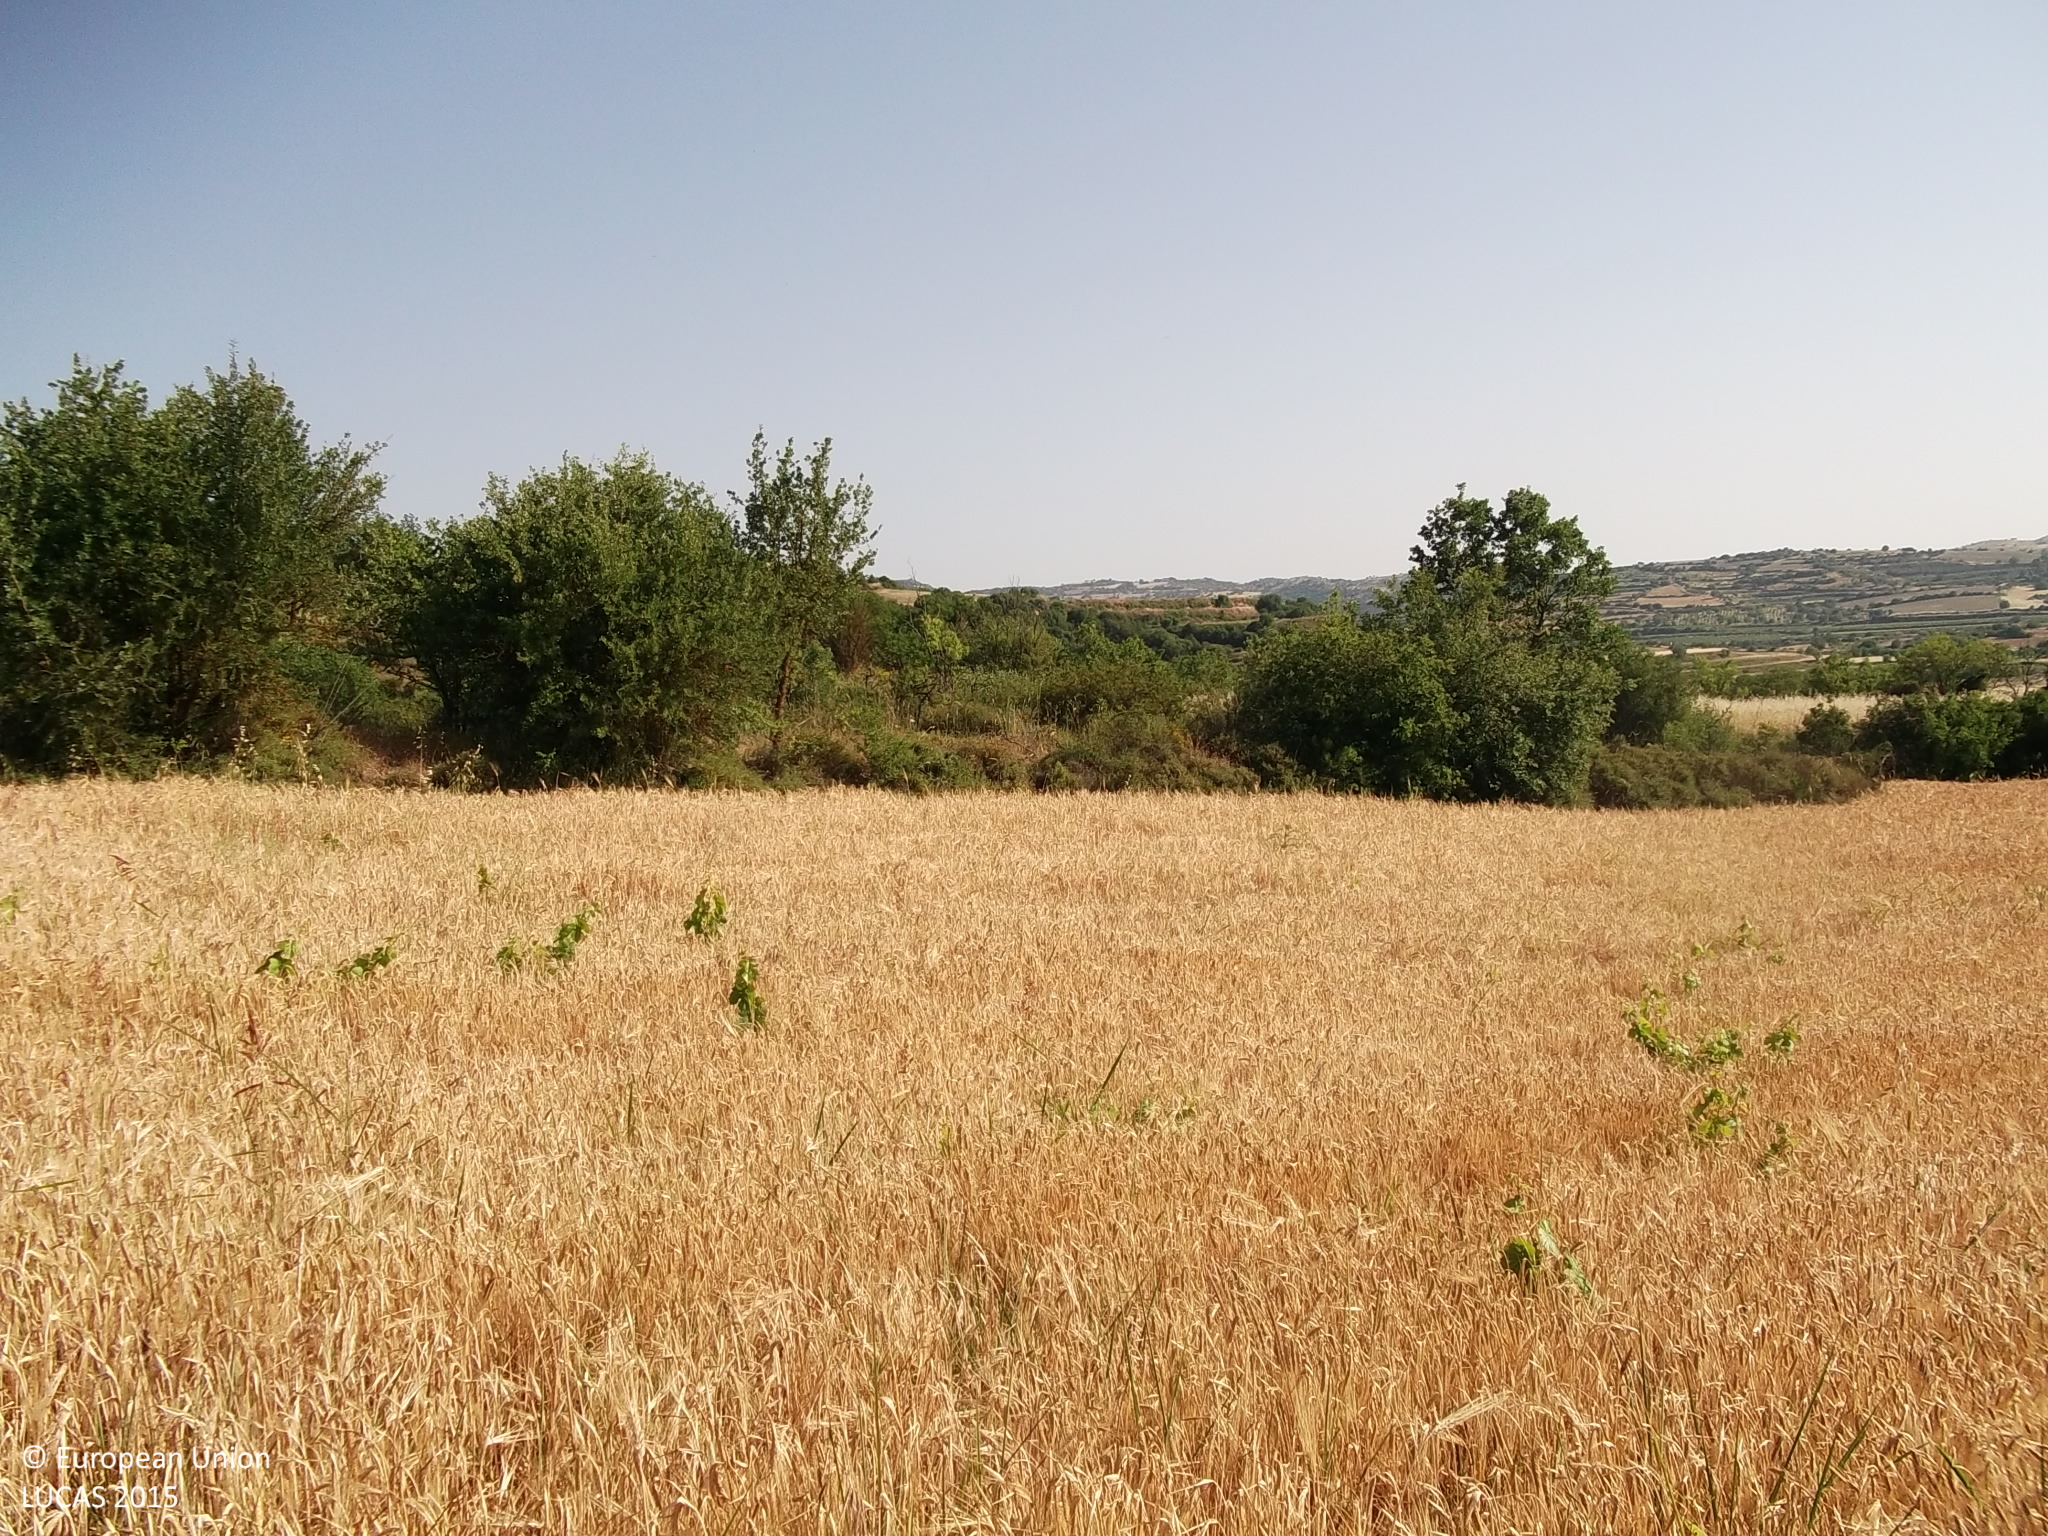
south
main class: Cropland
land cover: Barley
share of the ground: > 75 %
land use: Agriculture (excluding fallow land and kitchen gardens)
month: May
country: CY
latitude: 34.8488
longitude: 32.5614
